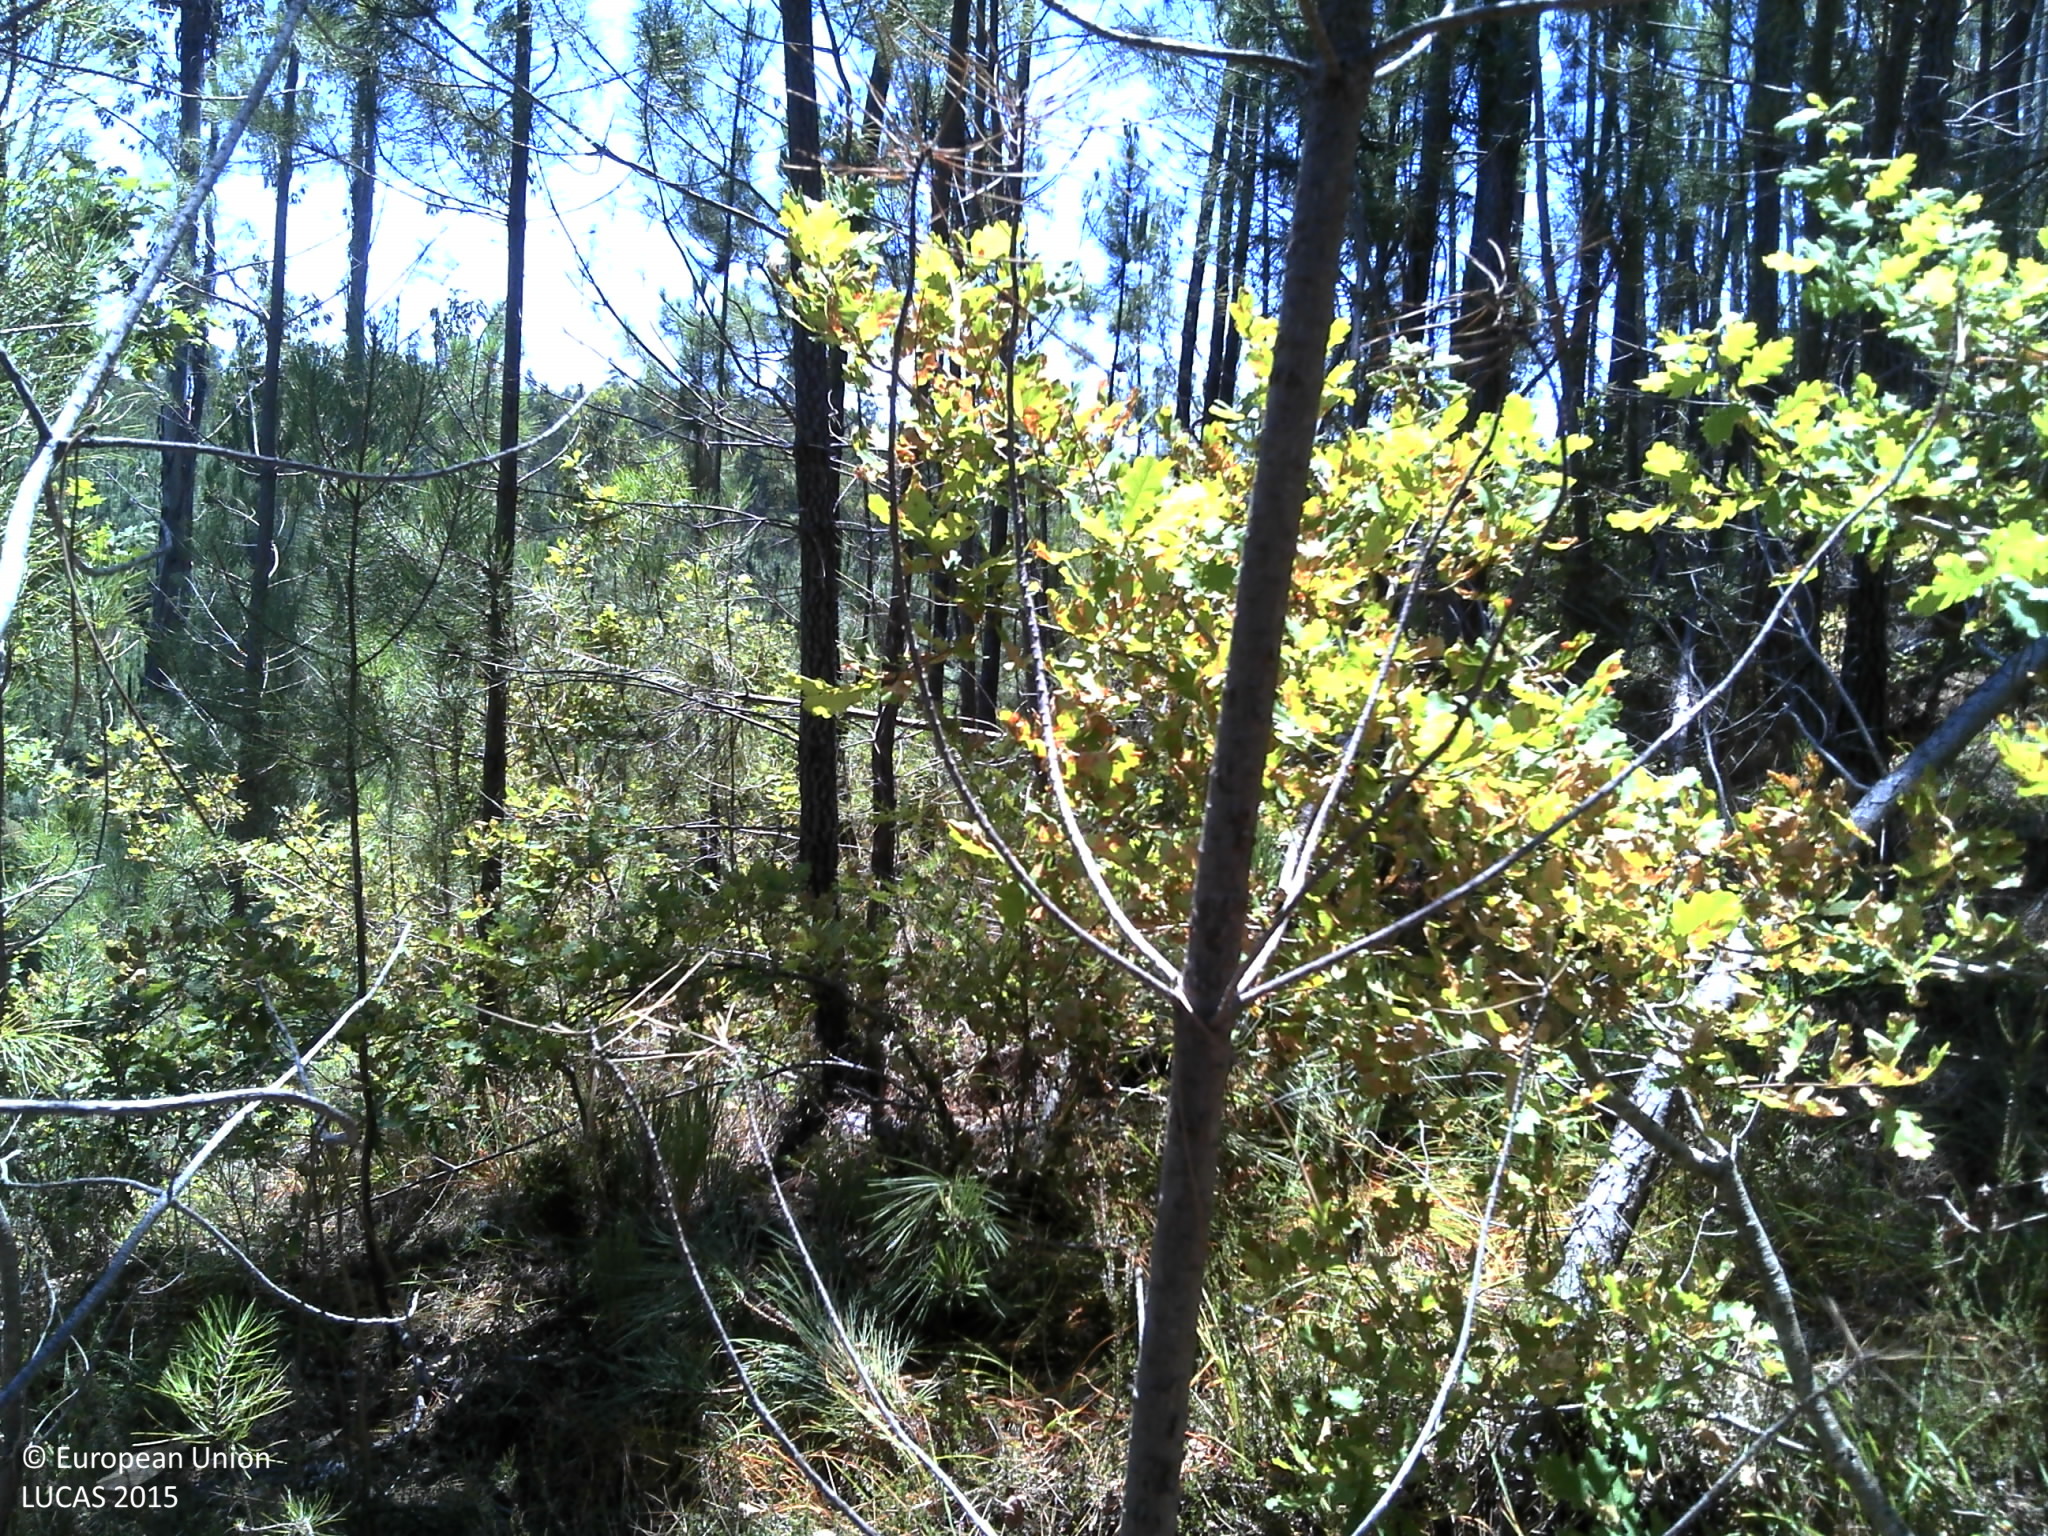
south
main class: Woodland
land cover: Pine dominated mixed woodland
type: coniferous forest of the mediterranean region
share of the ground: 10 - 25 %
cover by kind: shrubs 40 %, unconsolidated bare surface 30 %, coniferous forest trees 15 %, herbaceous plants 10 %, broadleaved forest trees 5 %
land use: Forestry
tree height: > 5 m
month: July
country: PT
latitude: 39.9530
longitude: -8.2043
